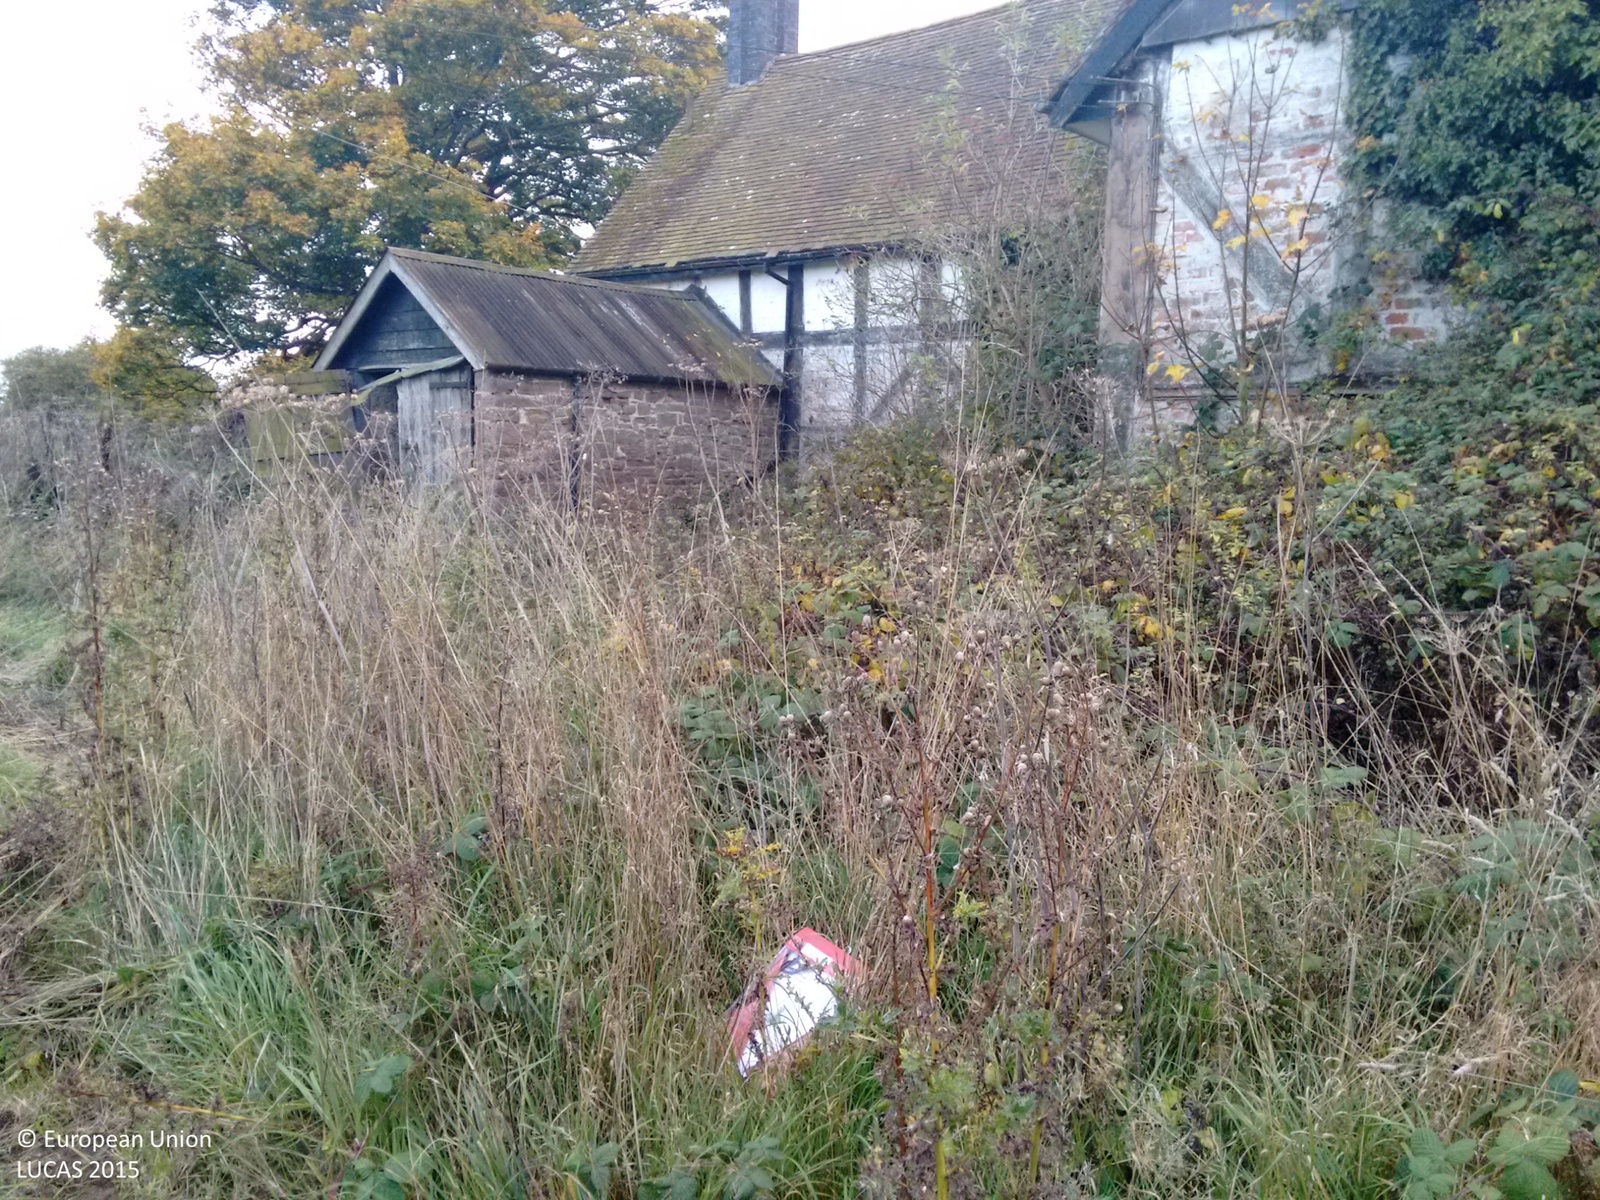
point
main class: Grassland
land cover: Grassland without tree/shrub cover
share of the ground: > 75 %
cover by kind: herbaceous plants 100 %
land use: Agriculture (excluding fallow land and kitchen gardens)
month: October
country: GB
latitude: 52.3962
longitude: -2.7534
